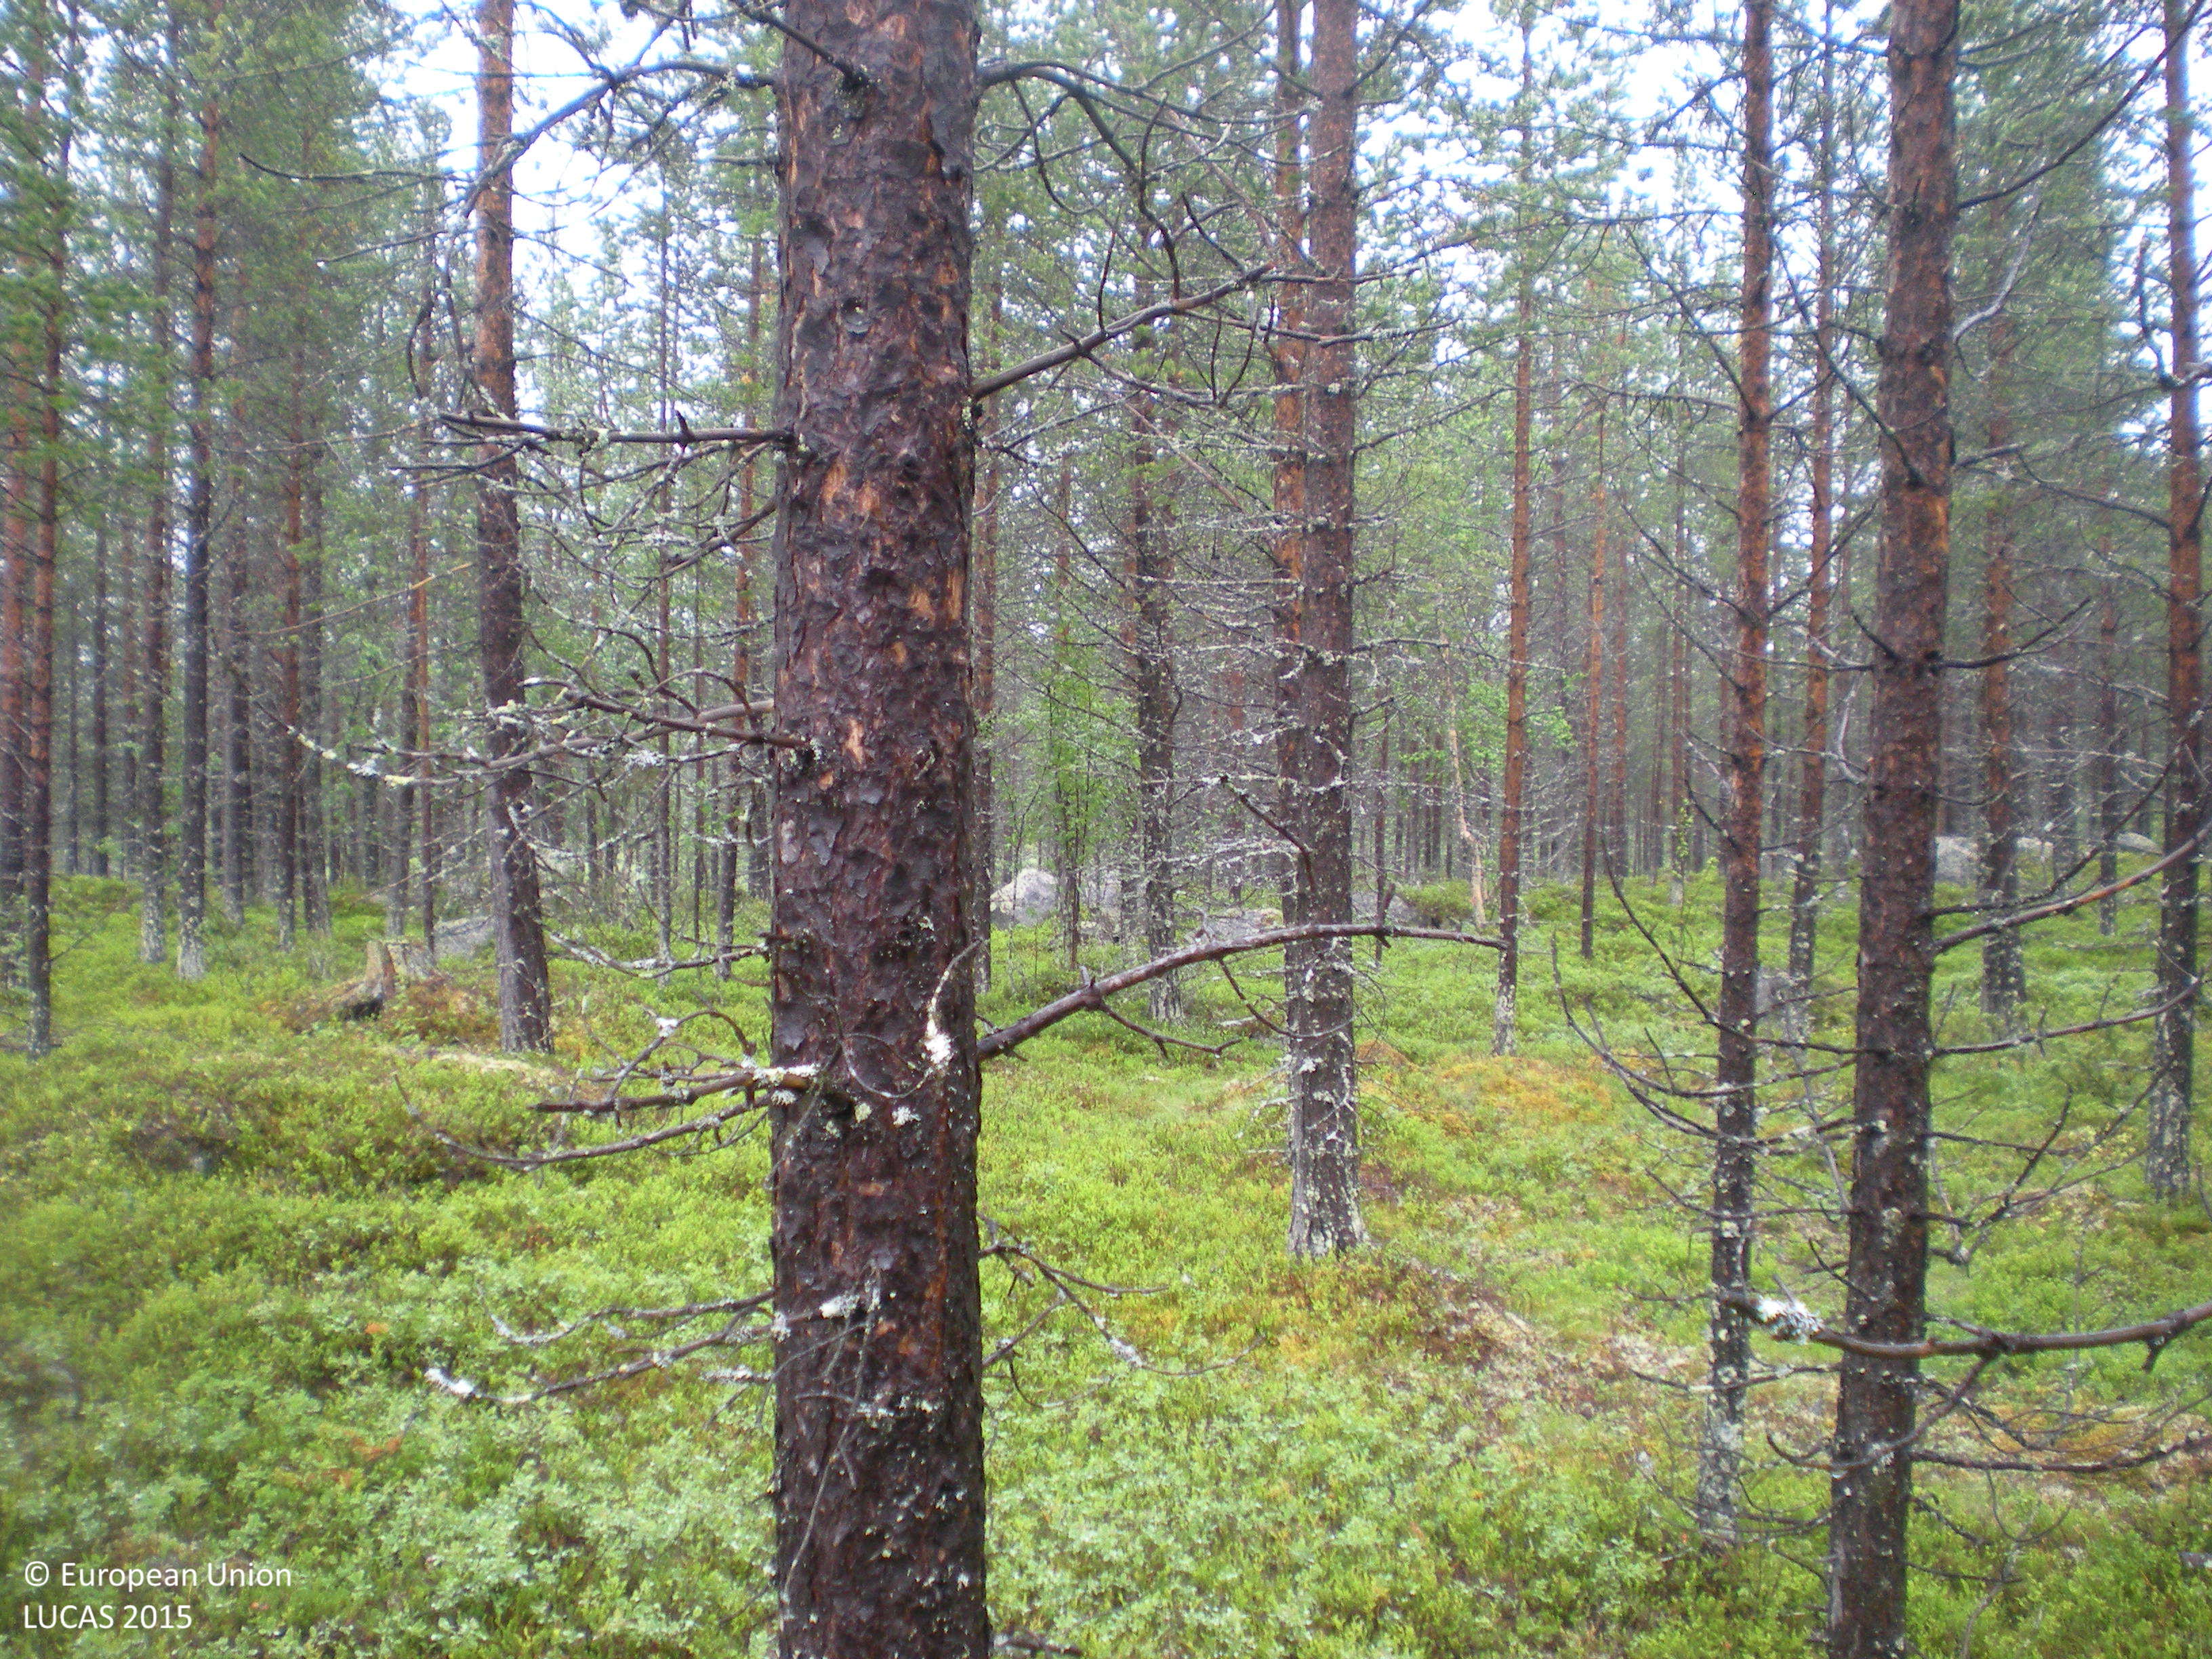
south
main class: Woodland
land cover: Pine dominated coniferous woodland
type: boreal forest
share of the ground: 50 - 75 %
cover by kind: coniferous forest trees 60 %, shrubs 35 %, lichens and mosses 5 %
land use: Forestry
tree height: > 5 m
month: July
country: SE
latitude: 65.9655
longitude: 18.2512
